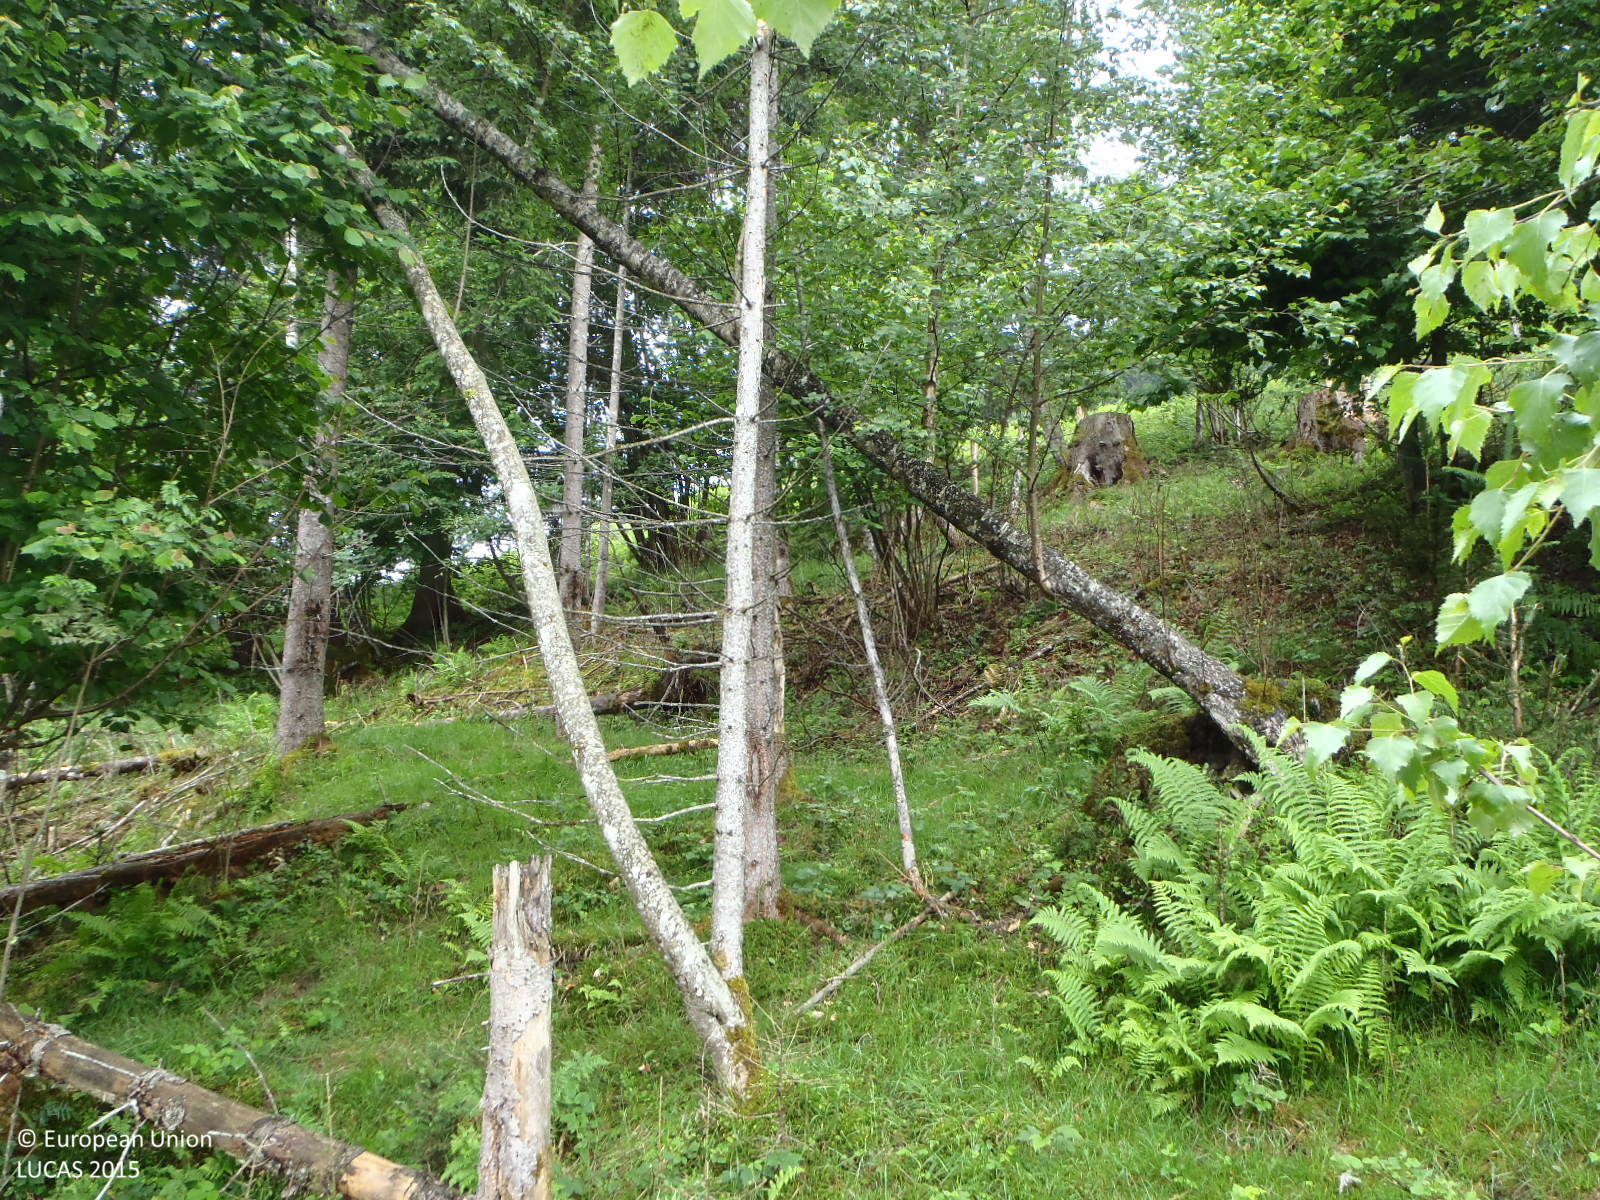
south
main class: Shrubland
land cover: Shrubland with sparse tree cover
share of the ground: > 75 %
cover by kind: shrubs 60 %, herbaceous plants 35 %, coniferous forest trees 5 %
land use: Forestry
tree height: < 5 m
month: June
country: AT
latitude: 47.3598
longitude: 12.7918
